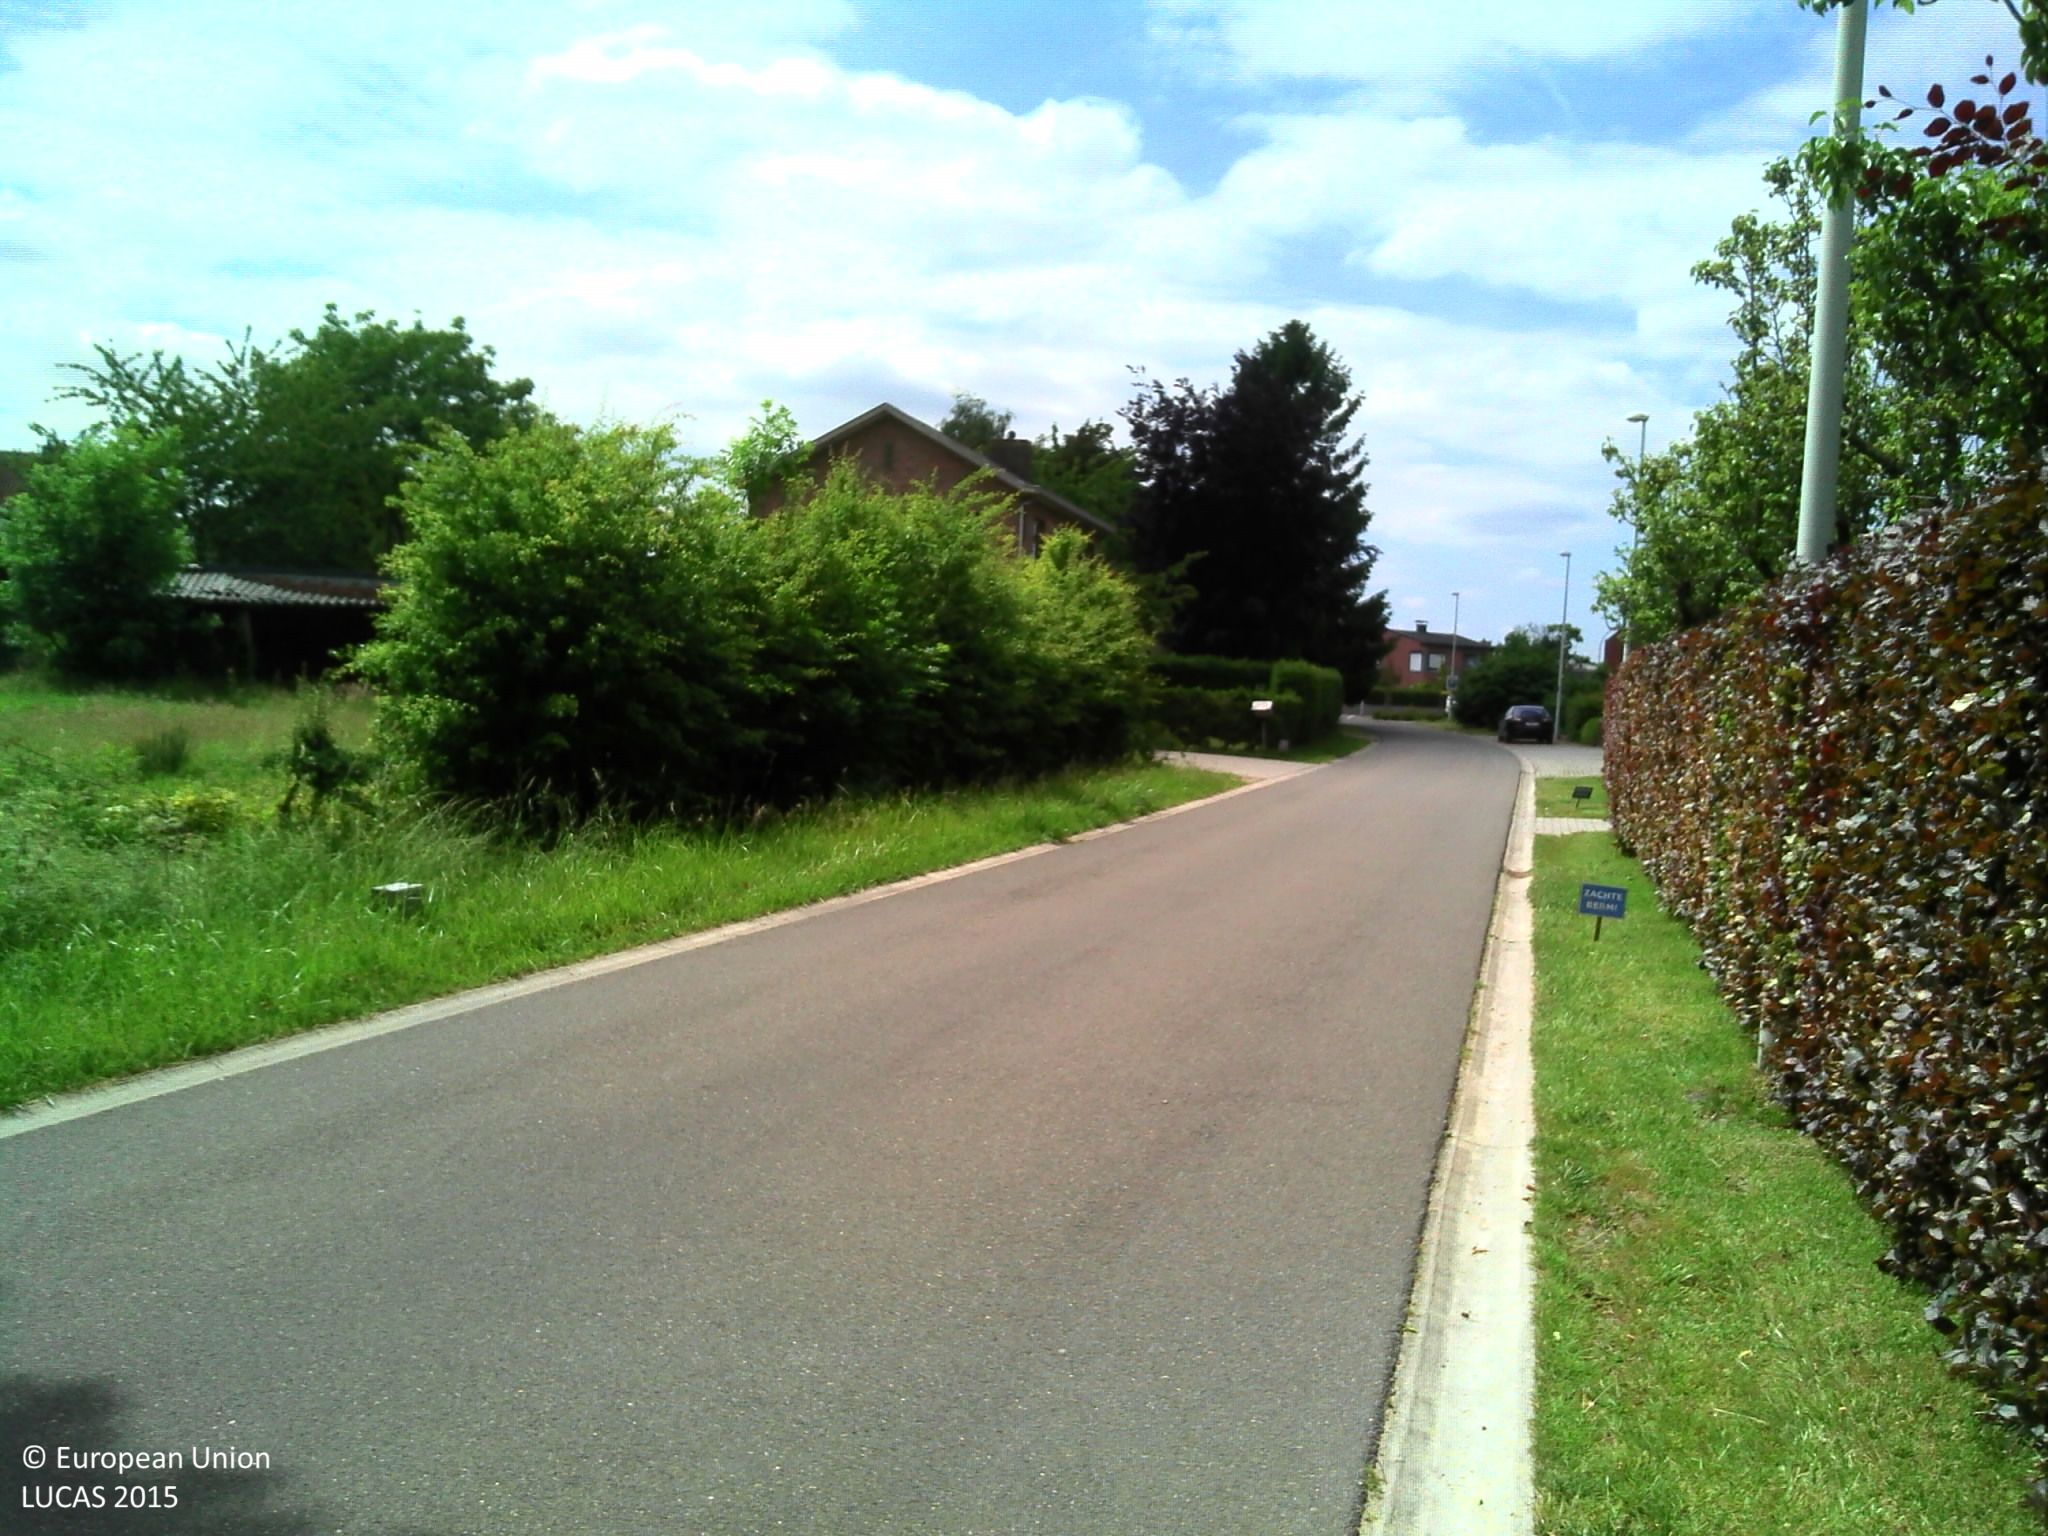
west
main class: Grassland
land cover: Grassland with sparse tree/shrub cover
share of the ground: > 75 %
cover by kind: herbaceous plants 95 %, broadleaved forest trees 5 %
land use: Residential
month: June
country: BE
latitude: 51.2304
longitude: 4.2810
